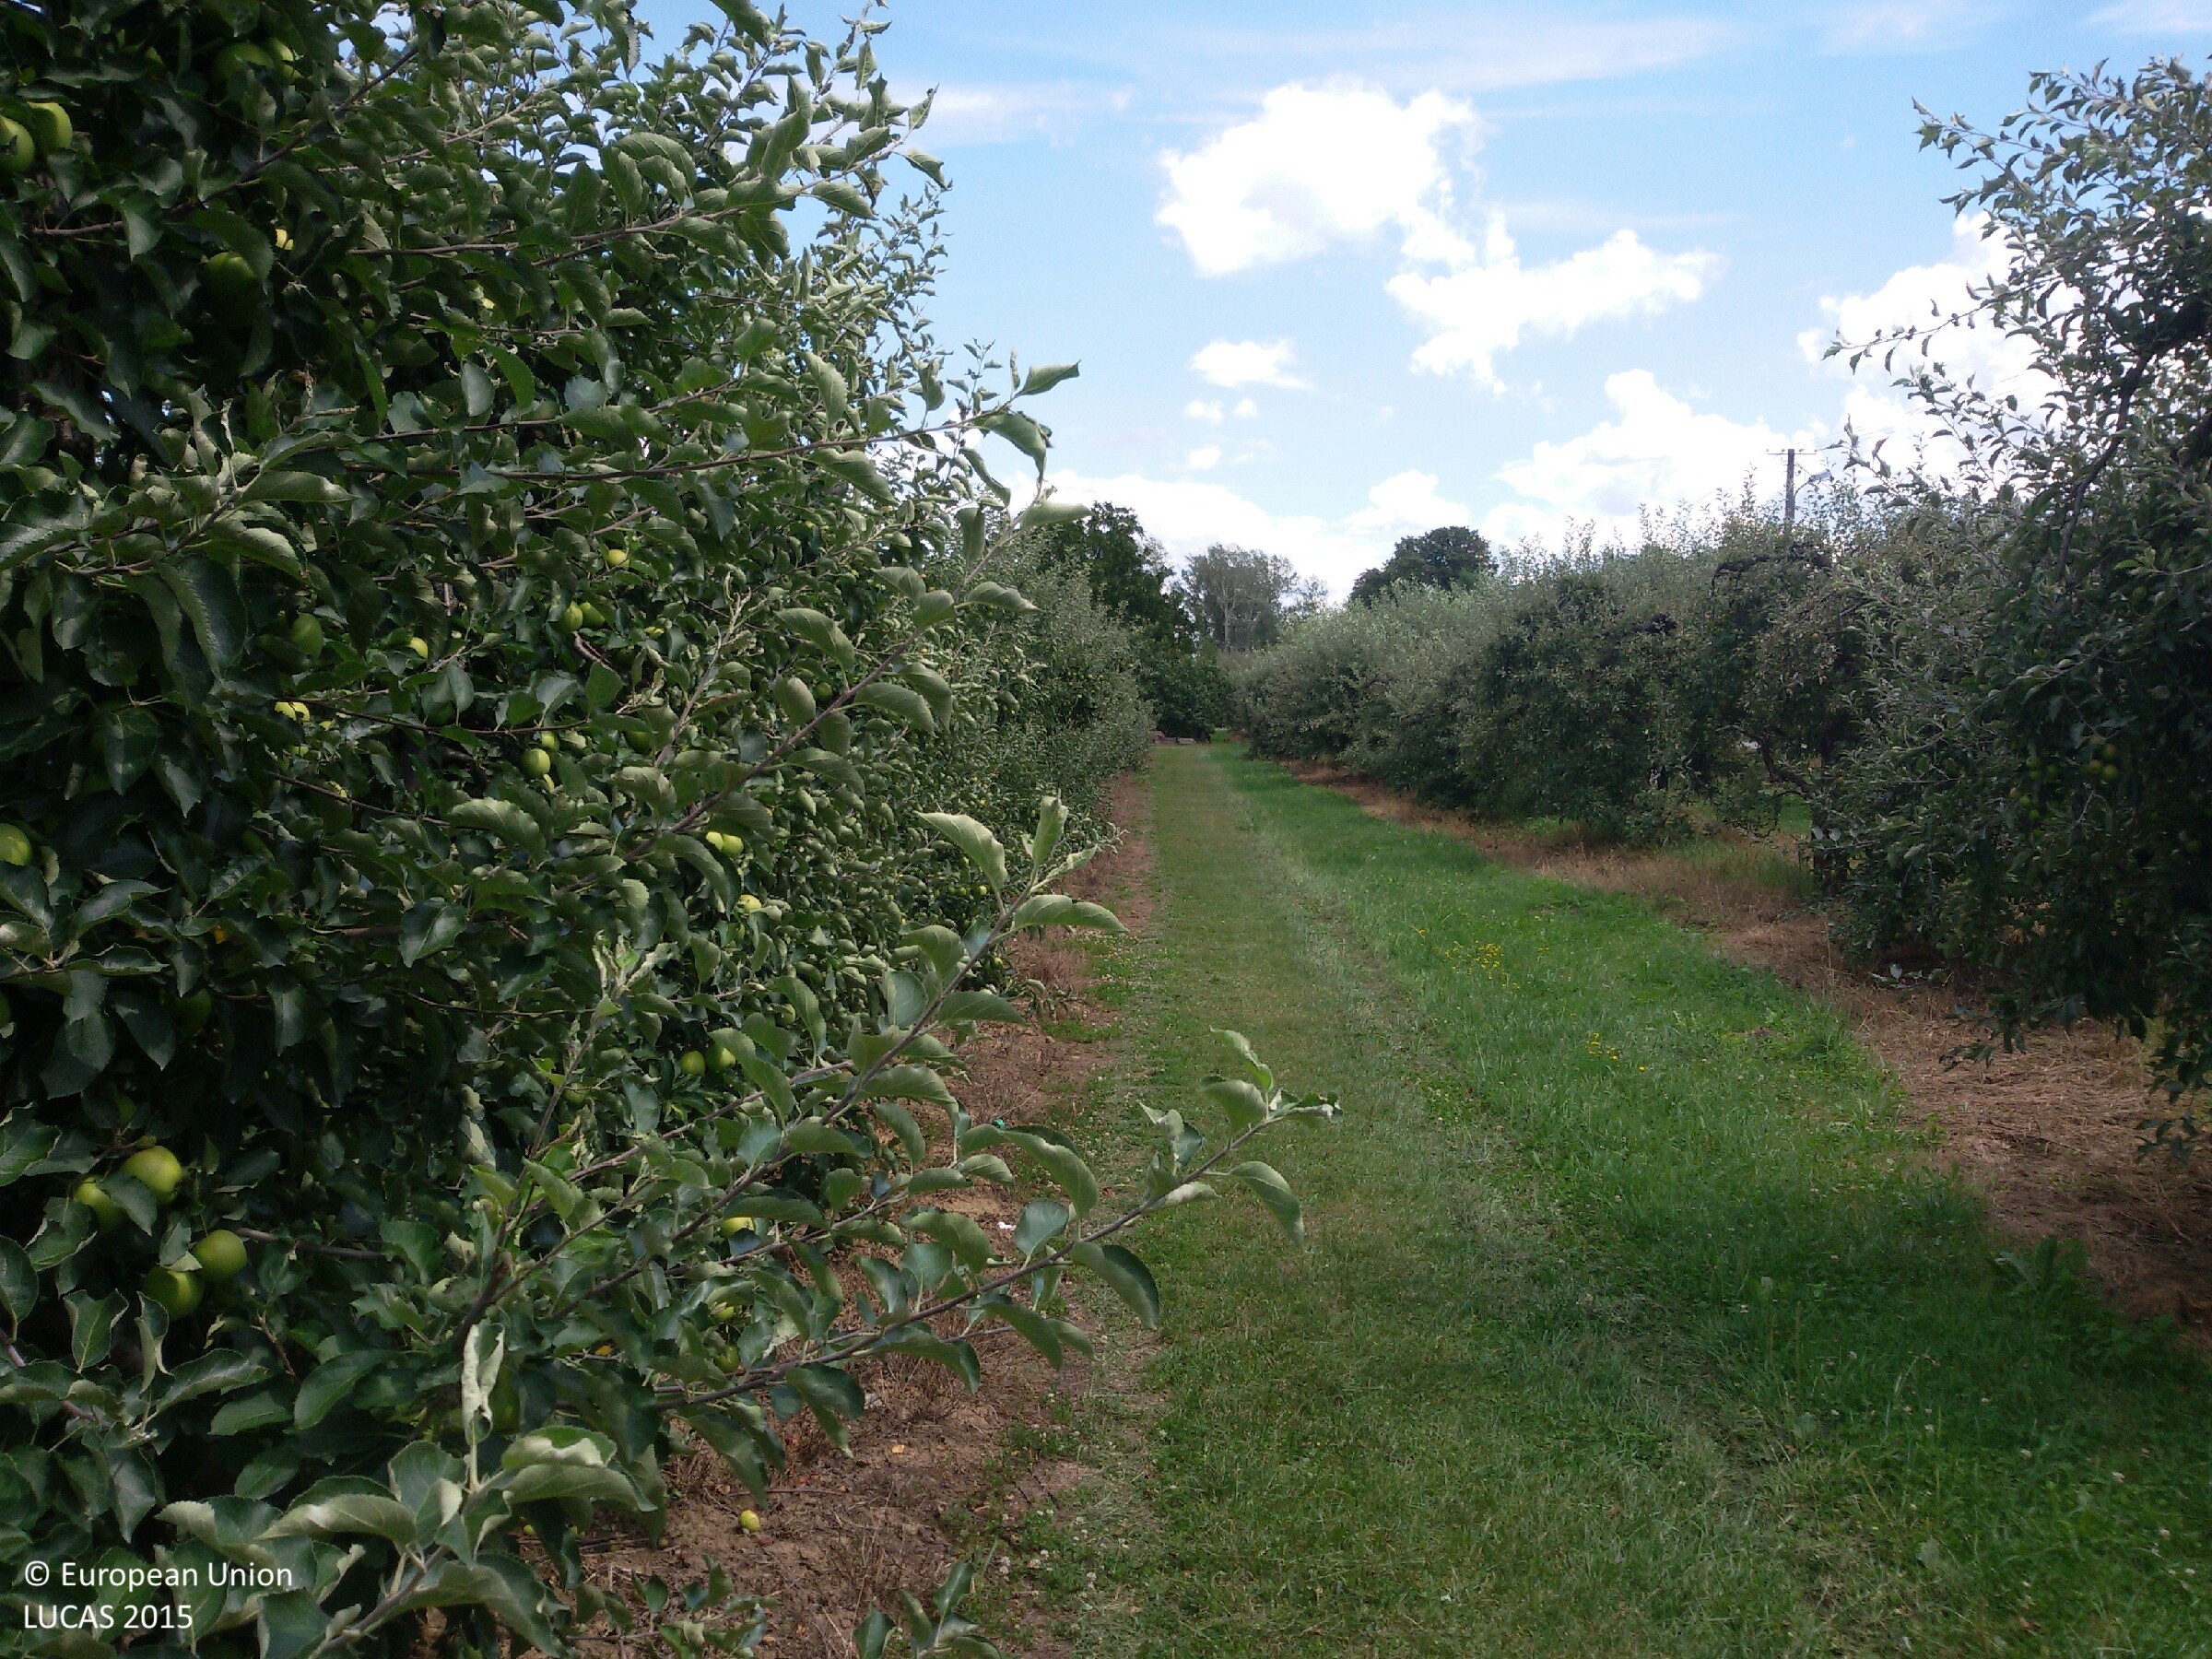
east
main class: Cropland
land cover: Apple fruit
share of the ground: > 75 %
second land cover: Grassland without tree/shrub cover
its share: > 75 %
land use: Agriculture (excluding fallow land and kitchen gardens)
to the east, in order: Apple fruit; Grassland without tree/shrub cover; Artificial constructions in urban areas; Apple fruit
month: July
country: PL
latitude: 50.5843
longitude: 21.6483
